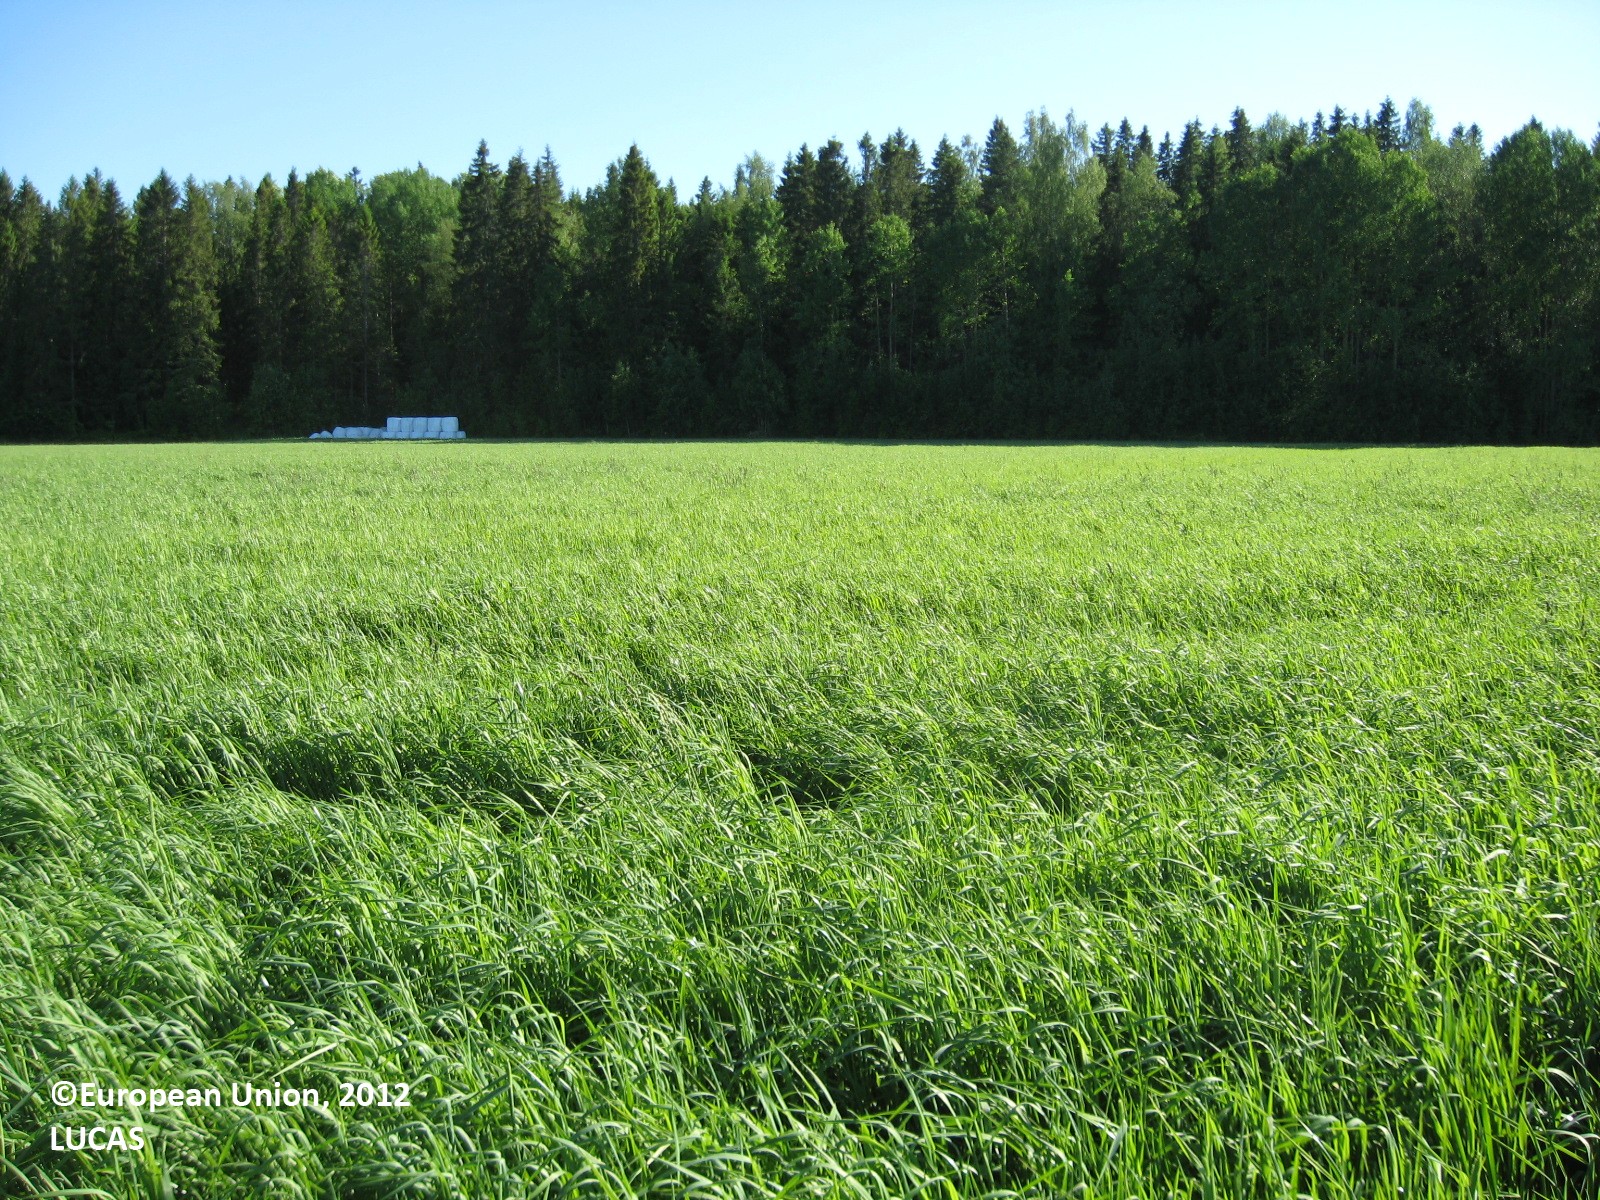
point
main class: Cropland
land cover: Temporary grasslands
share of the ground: > 75 %
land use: Agriculture (excluding fallow land and kitchen gardens)
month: June
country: FI
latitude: 63.0030
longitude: 21.8314
